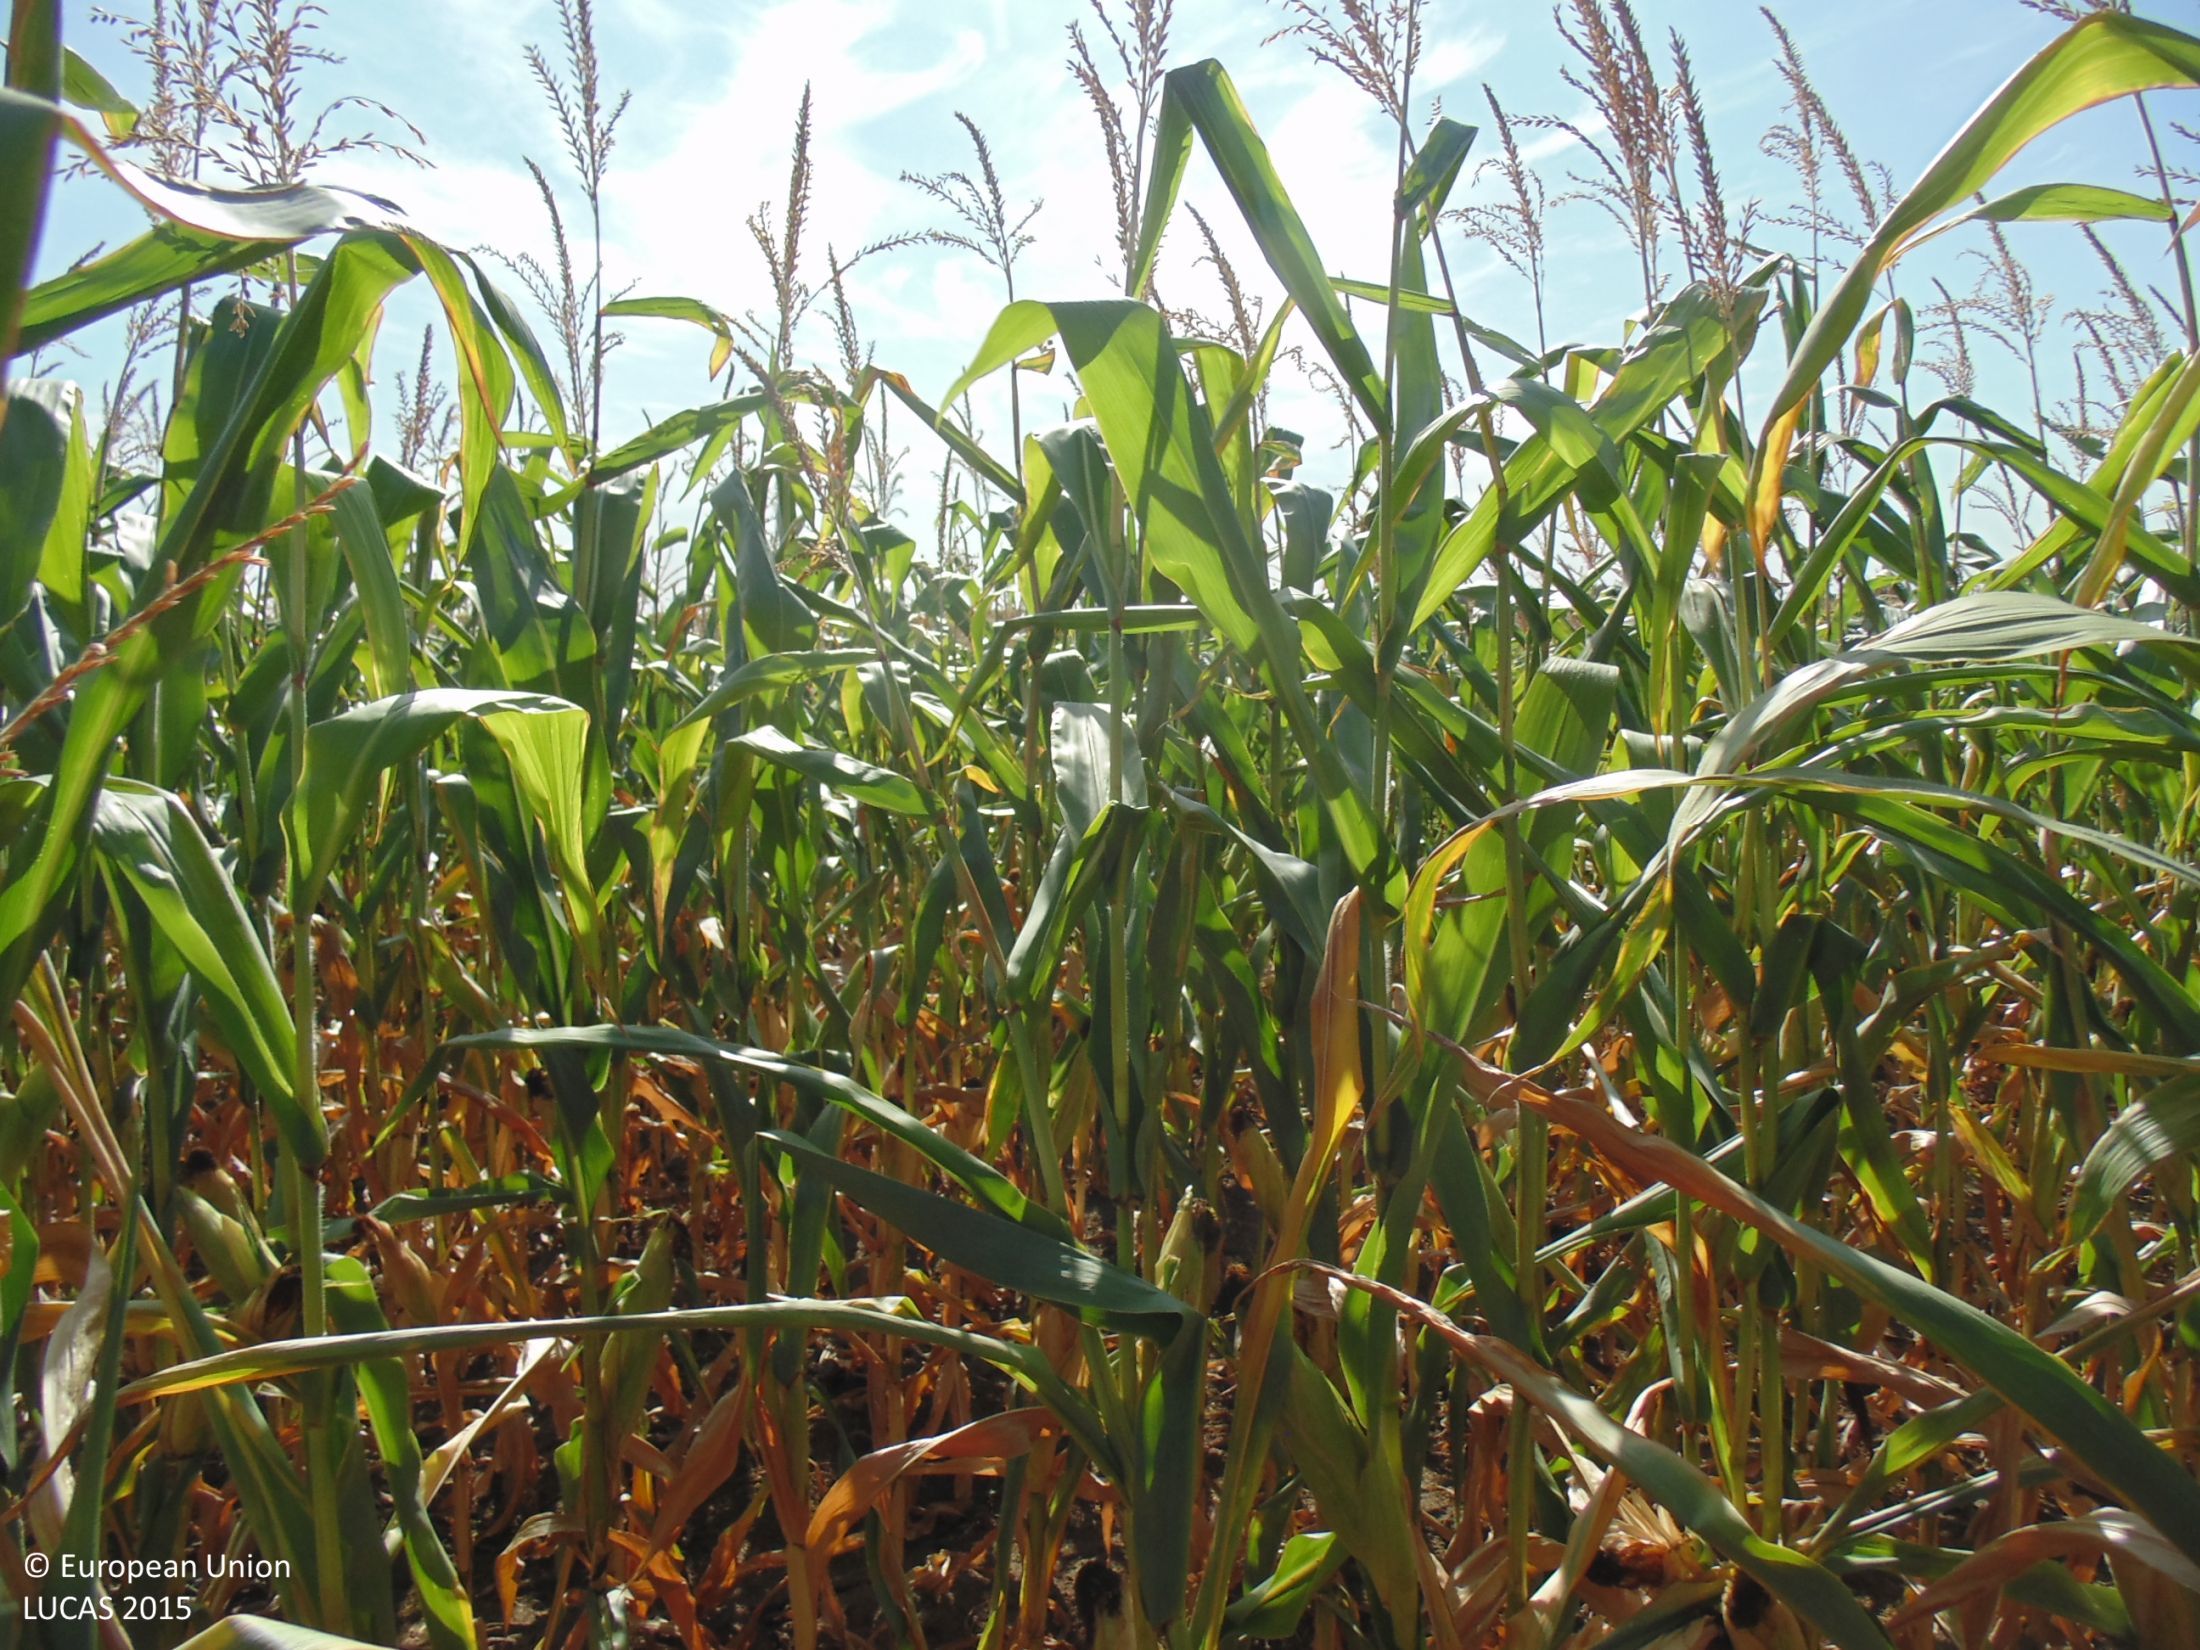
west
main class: Cropland
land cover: Maize
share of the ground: > 75 %
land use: Agriculture (excluding fallow land and kitchen gardens)
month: August
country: BG
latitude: 43.7867
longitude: 27.7245
